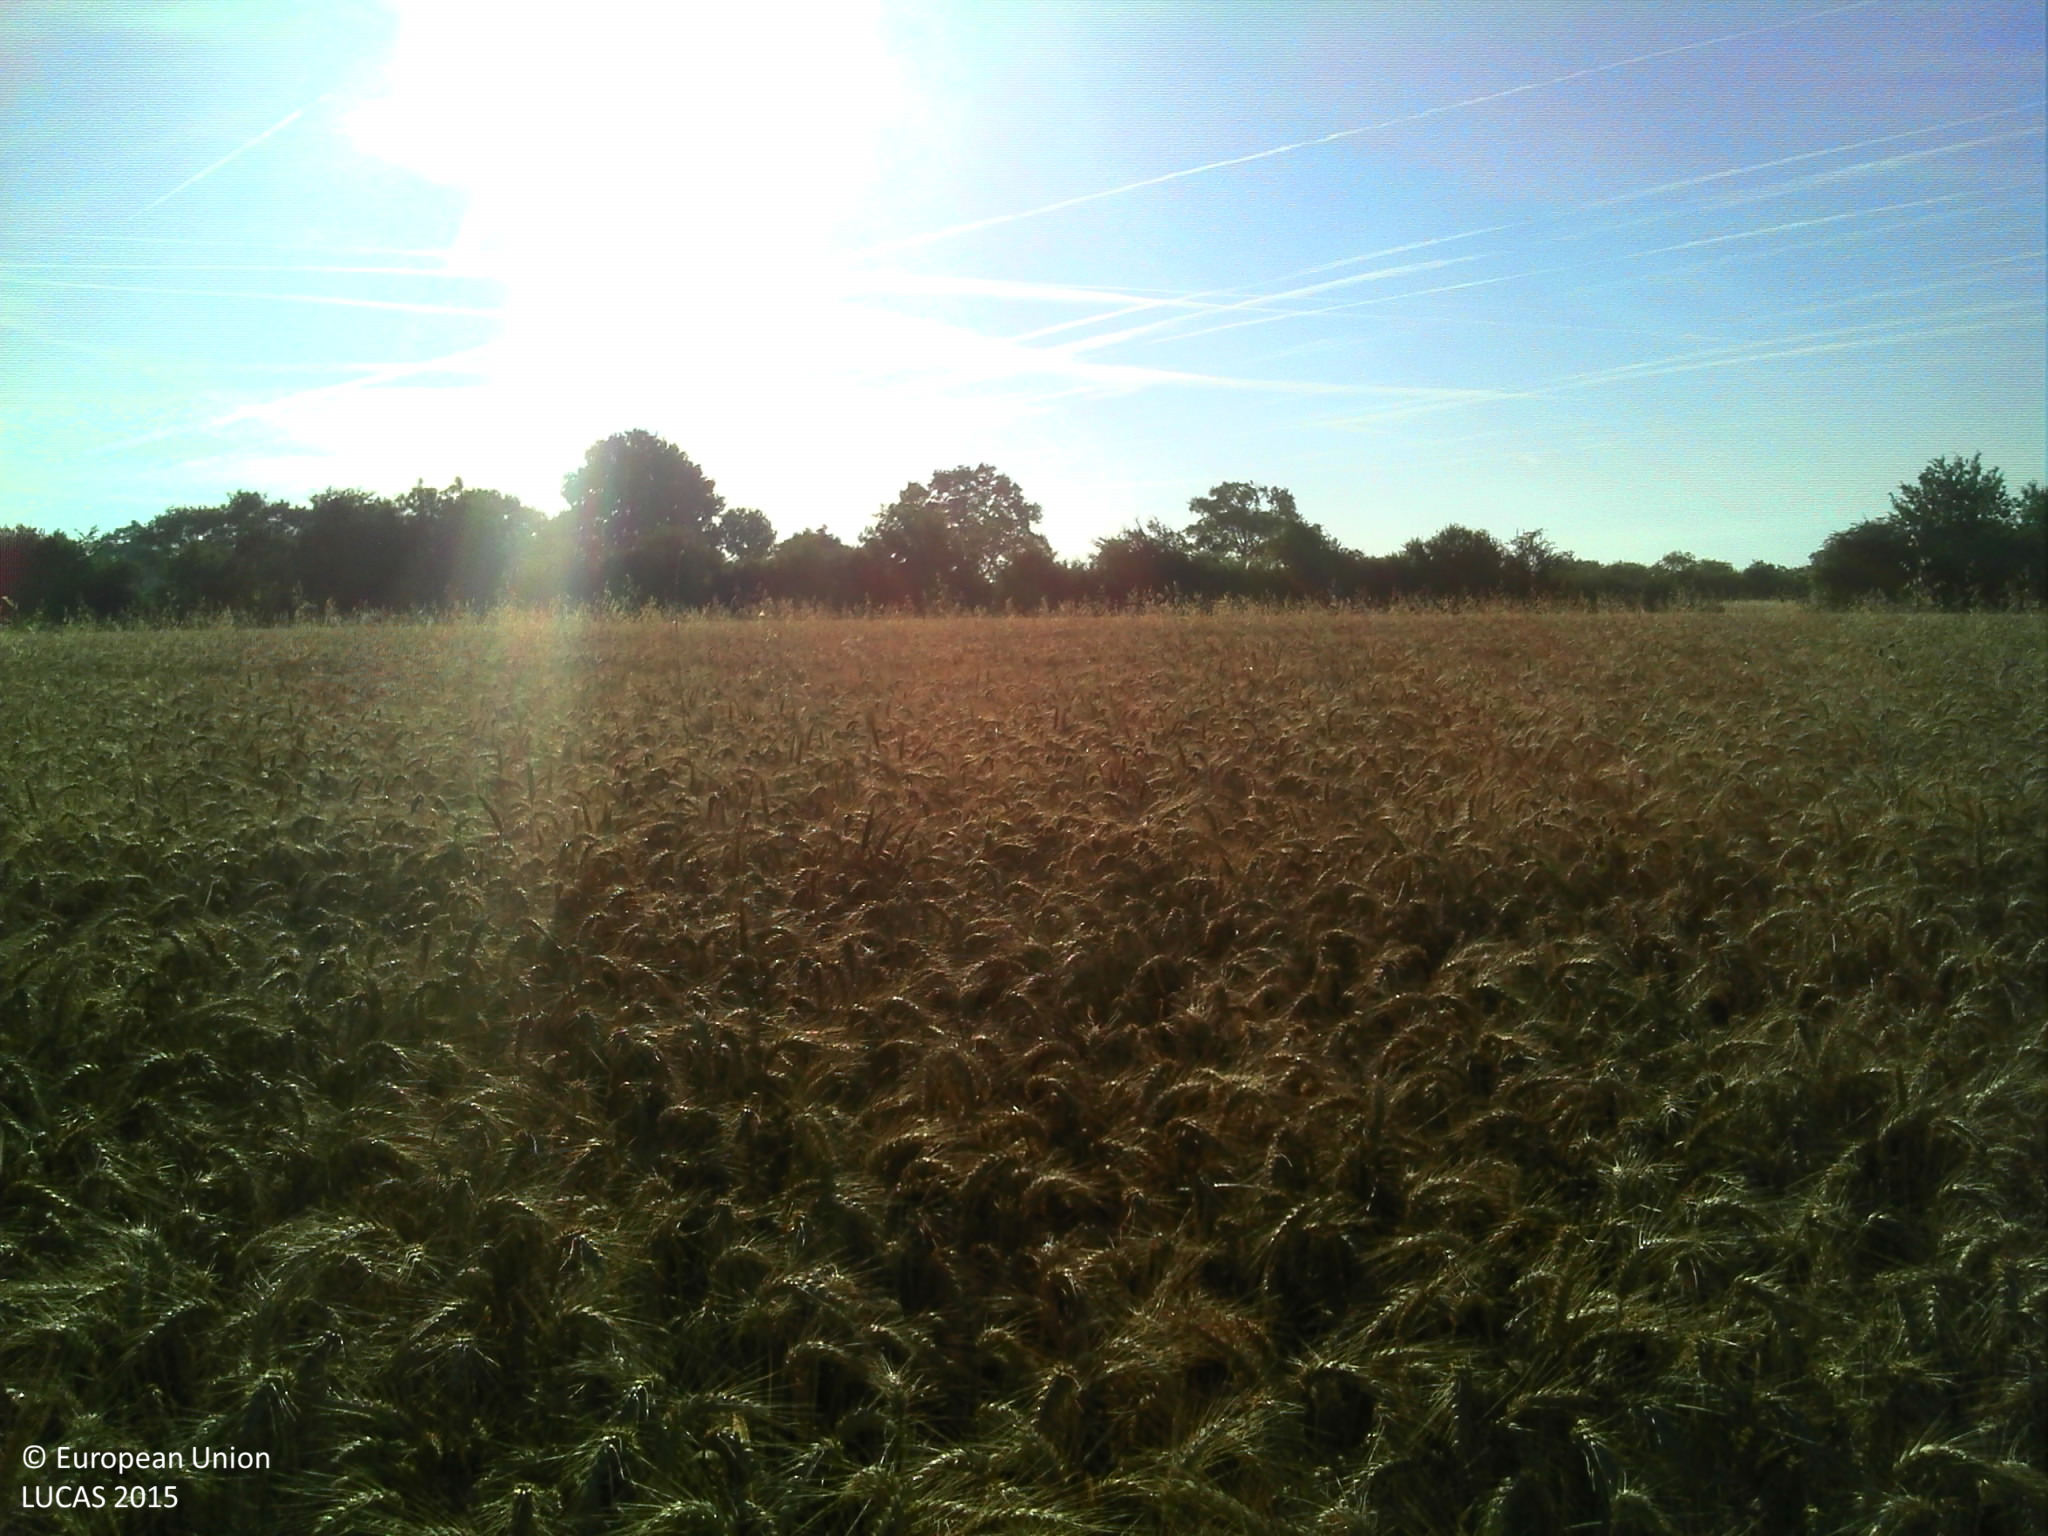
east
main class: Cropland
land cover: Common wheat
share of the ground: > 75 %
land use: Agriculture (excluding fallow land and kitchen gardens)
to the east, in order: Common wheat; Shrubland with sparse tree cover; Common wheat; Shrubland with sparse tree cover; Fences; Maize
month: July
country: FR
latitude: 47.1307
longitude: -1.8178
